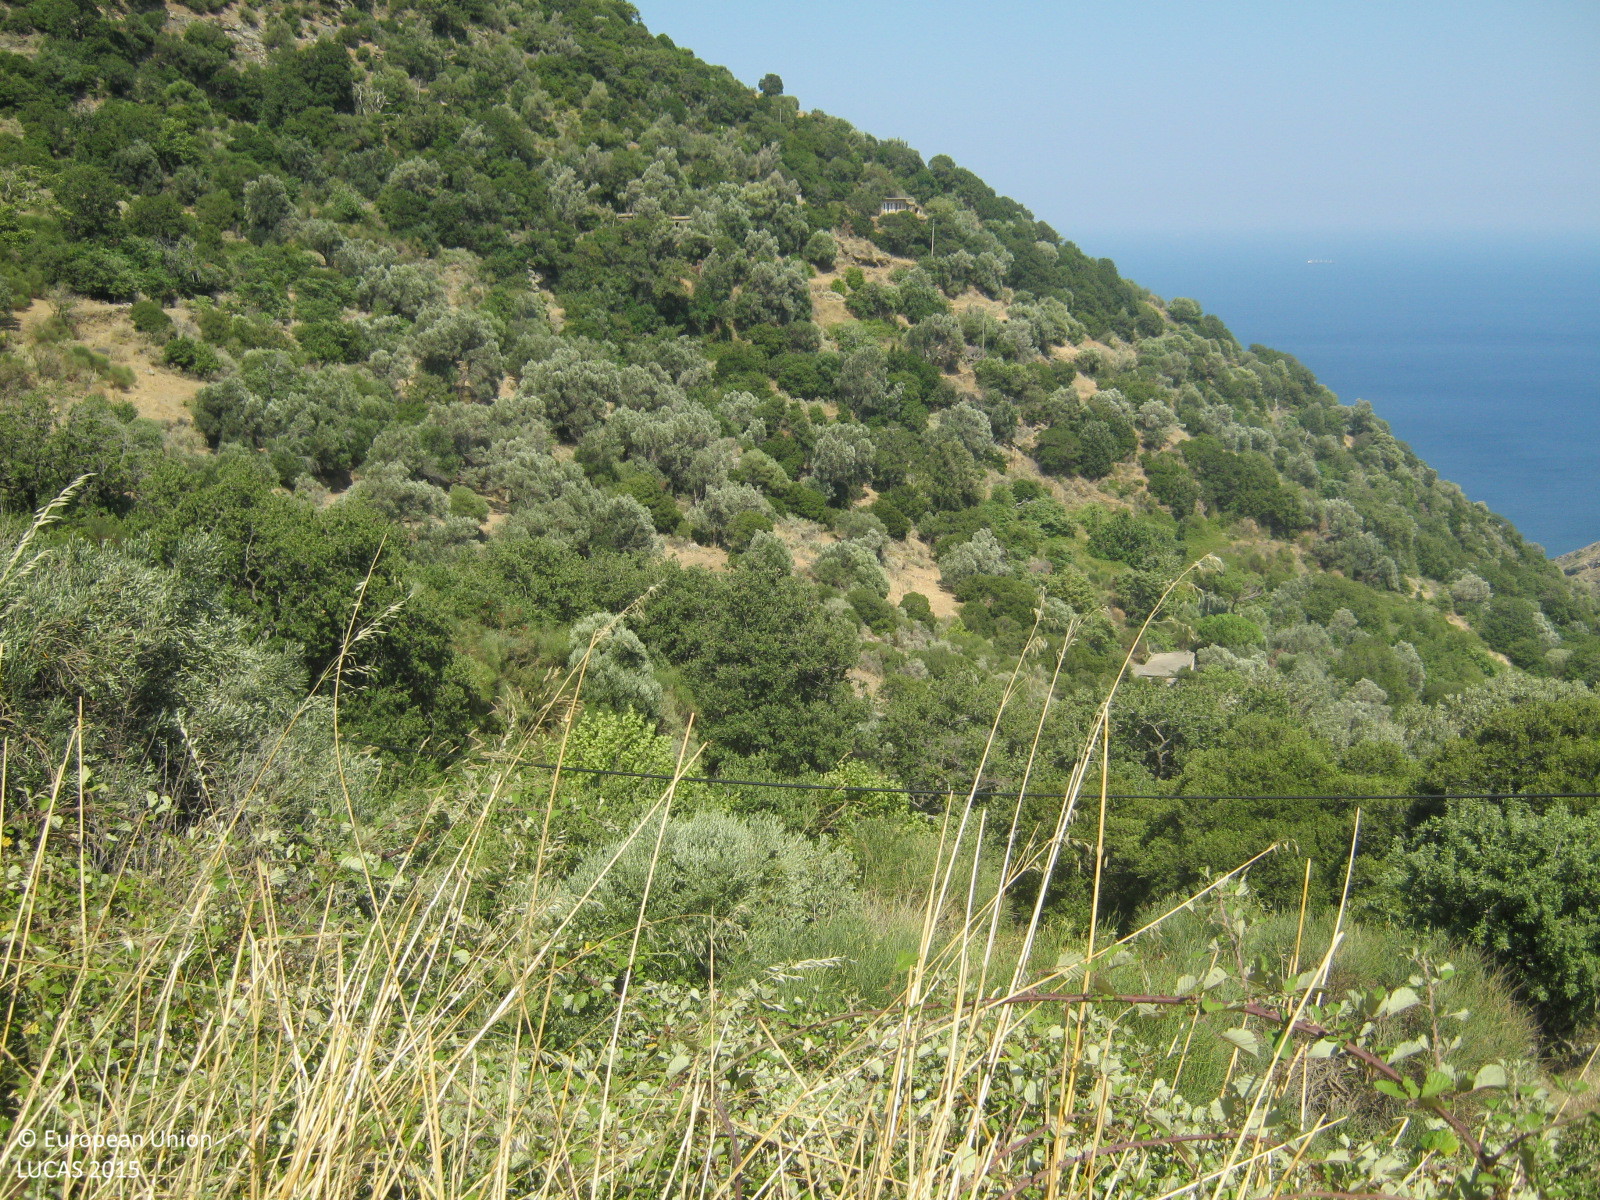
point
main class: Cropland
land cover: Olive groves
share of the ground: 25 - 50 %
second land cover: Shrubland without tree cover
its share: 50 - 75 %
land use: Agriculture (excluding fallow land and kitchen gardens)
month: July
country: GR
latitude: 38.1101
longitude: 24.5566
